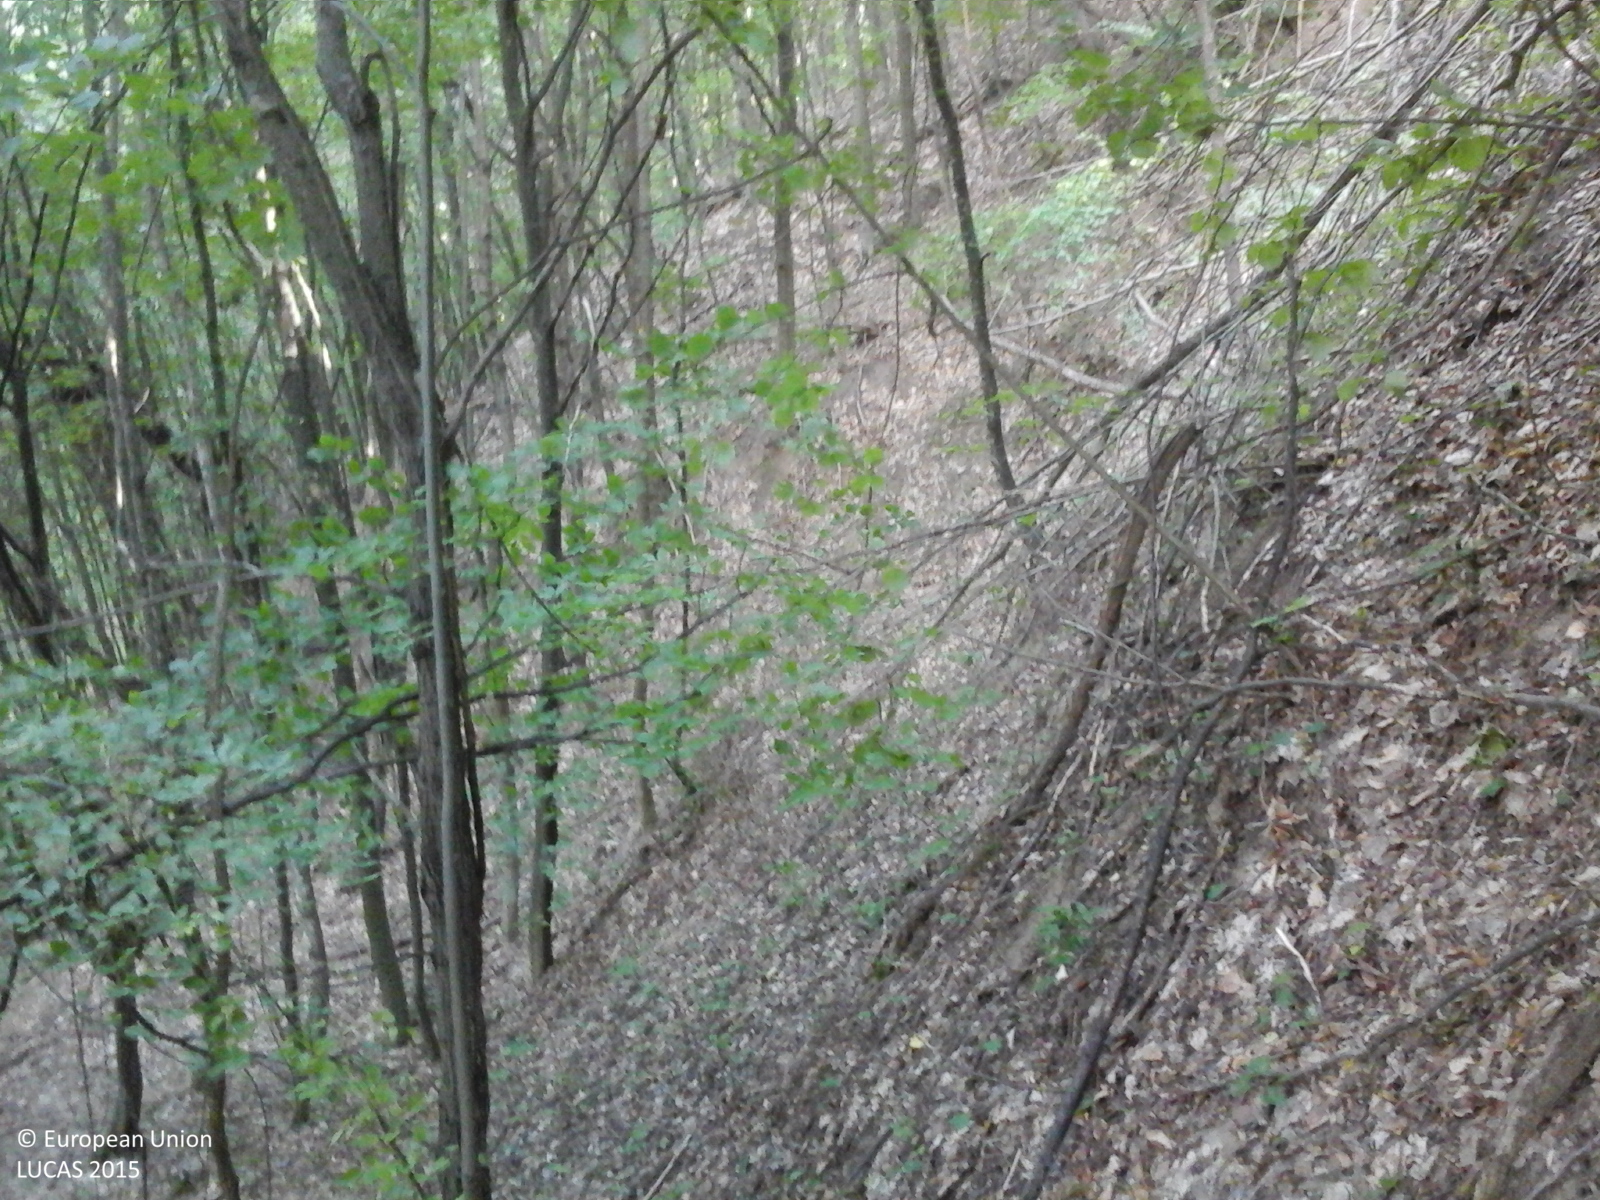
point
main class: Woodland
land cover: Broadleaved woodland
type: beech forest
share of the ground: > 75 %
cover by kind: broadleaved forest trees 100 %
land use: Forestry
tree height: > 5 m
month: June
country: RO
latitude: 46.7722
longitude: 27.2745
